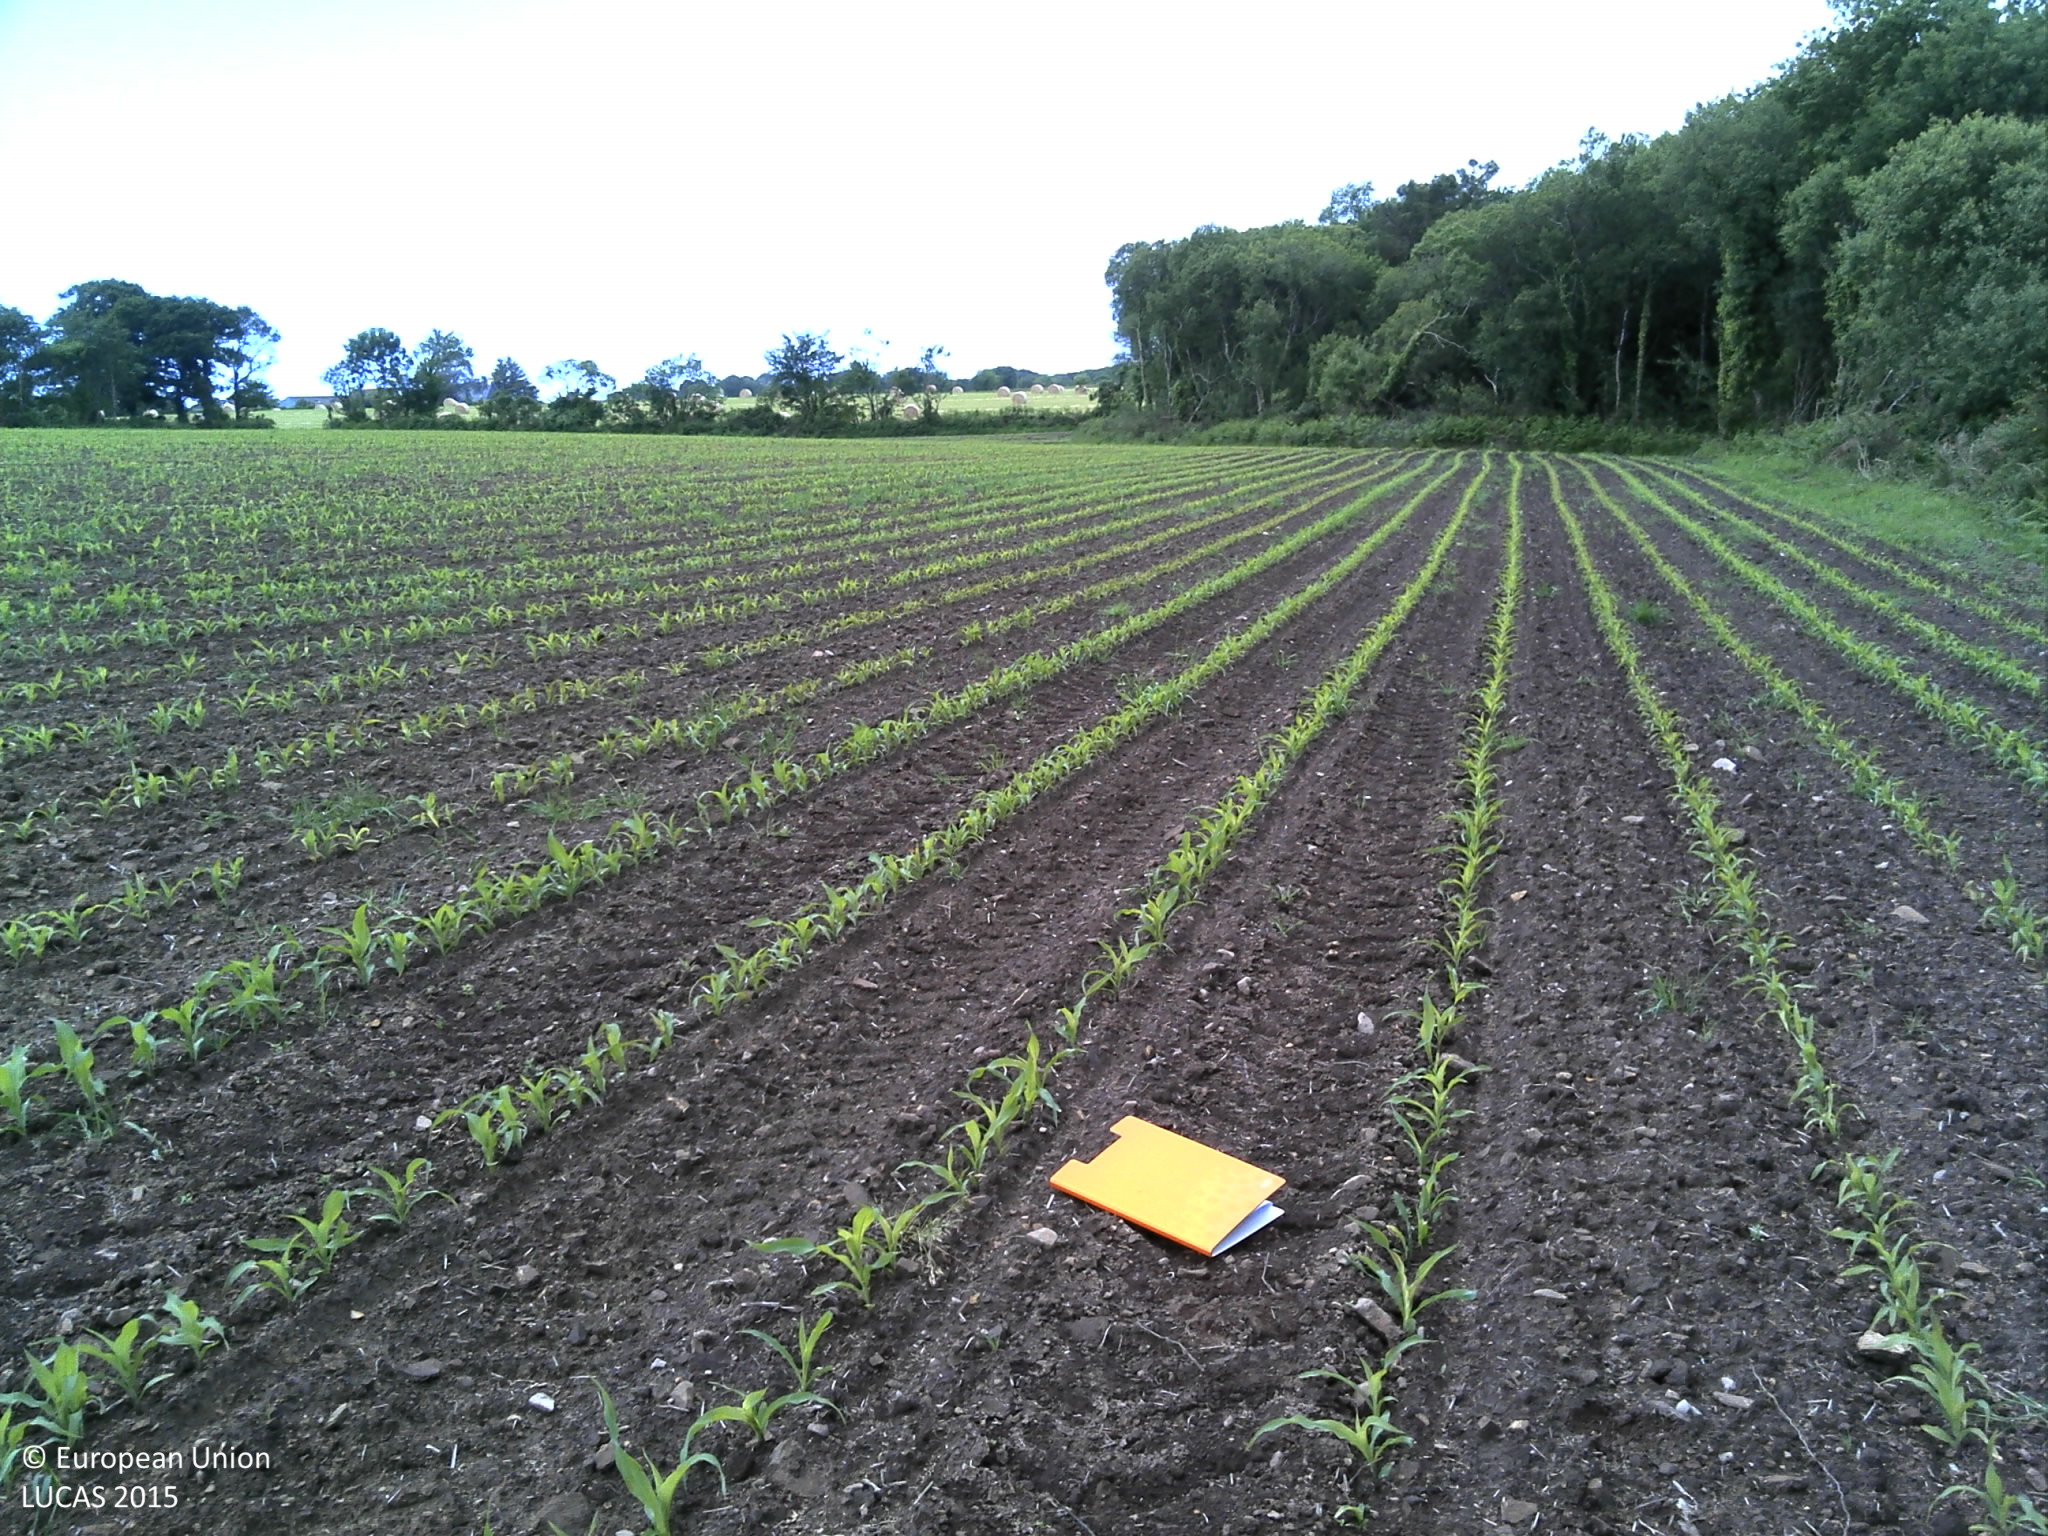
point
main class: Cropland
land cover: Maize
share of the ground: 10 - 25 %
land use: Agriculture (excluding fallow land and kitchen gardens)
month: September
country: FR
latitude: 47.8020
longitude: -3.5483
